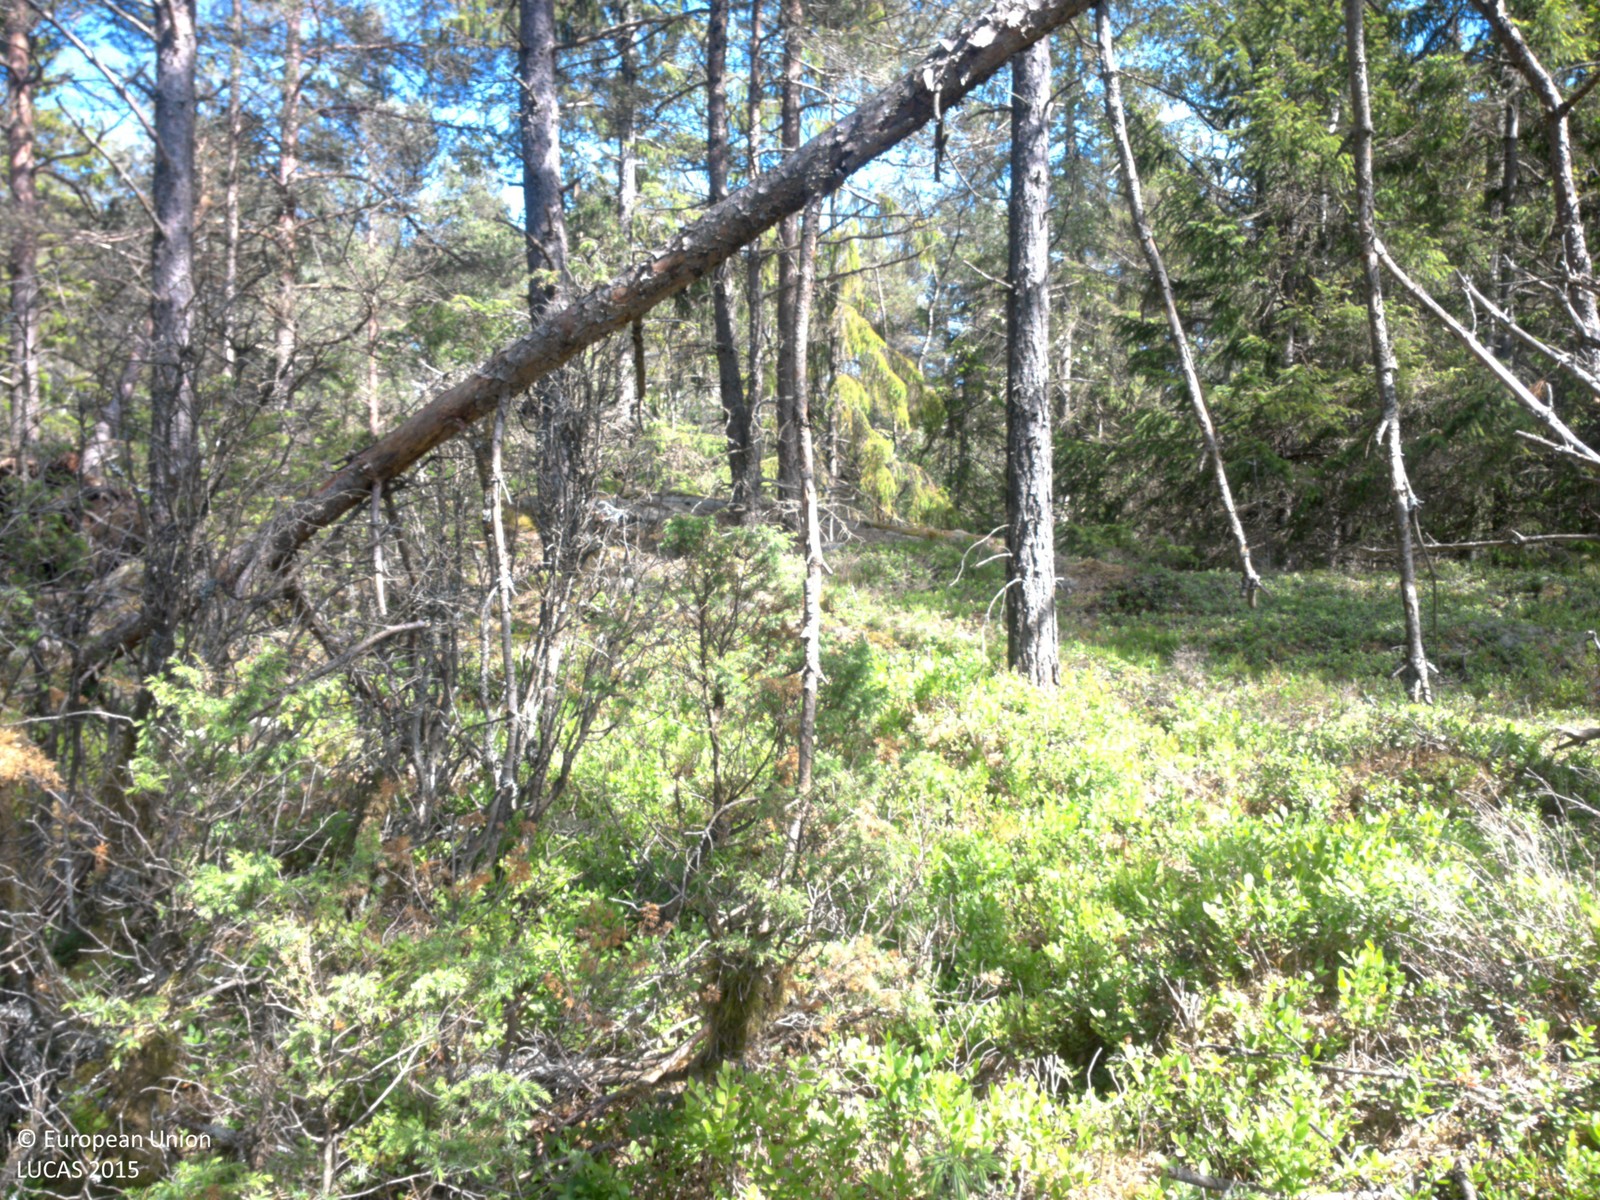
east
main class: Woodland
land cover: Pine dominated coniferous woodland
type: boreal forest
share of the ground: 50 - 75 %
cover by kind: coniferous forest trees 50 %, lichens and mosses 40 %, shrubs 10 %
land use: Forestry
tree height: > 5 m
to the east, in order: Pine dominated coniferous woodland; Pine dominated mixed woodland; Rock outcrops; Spruce dominated mixed woodland; Pine dominated coniferous woodland; Spruce dominated mixed woodland; Dry stone walls; Pine dominated coniferous woodland; Paved roads, cycling and walking lanes; Grass margins; Spruce dominated coniferous woodland; Electric lines; Rock outcrops; Spruce dominated coniferous woodland
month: June
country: SE
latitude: 58.6066
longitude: 11.5285
